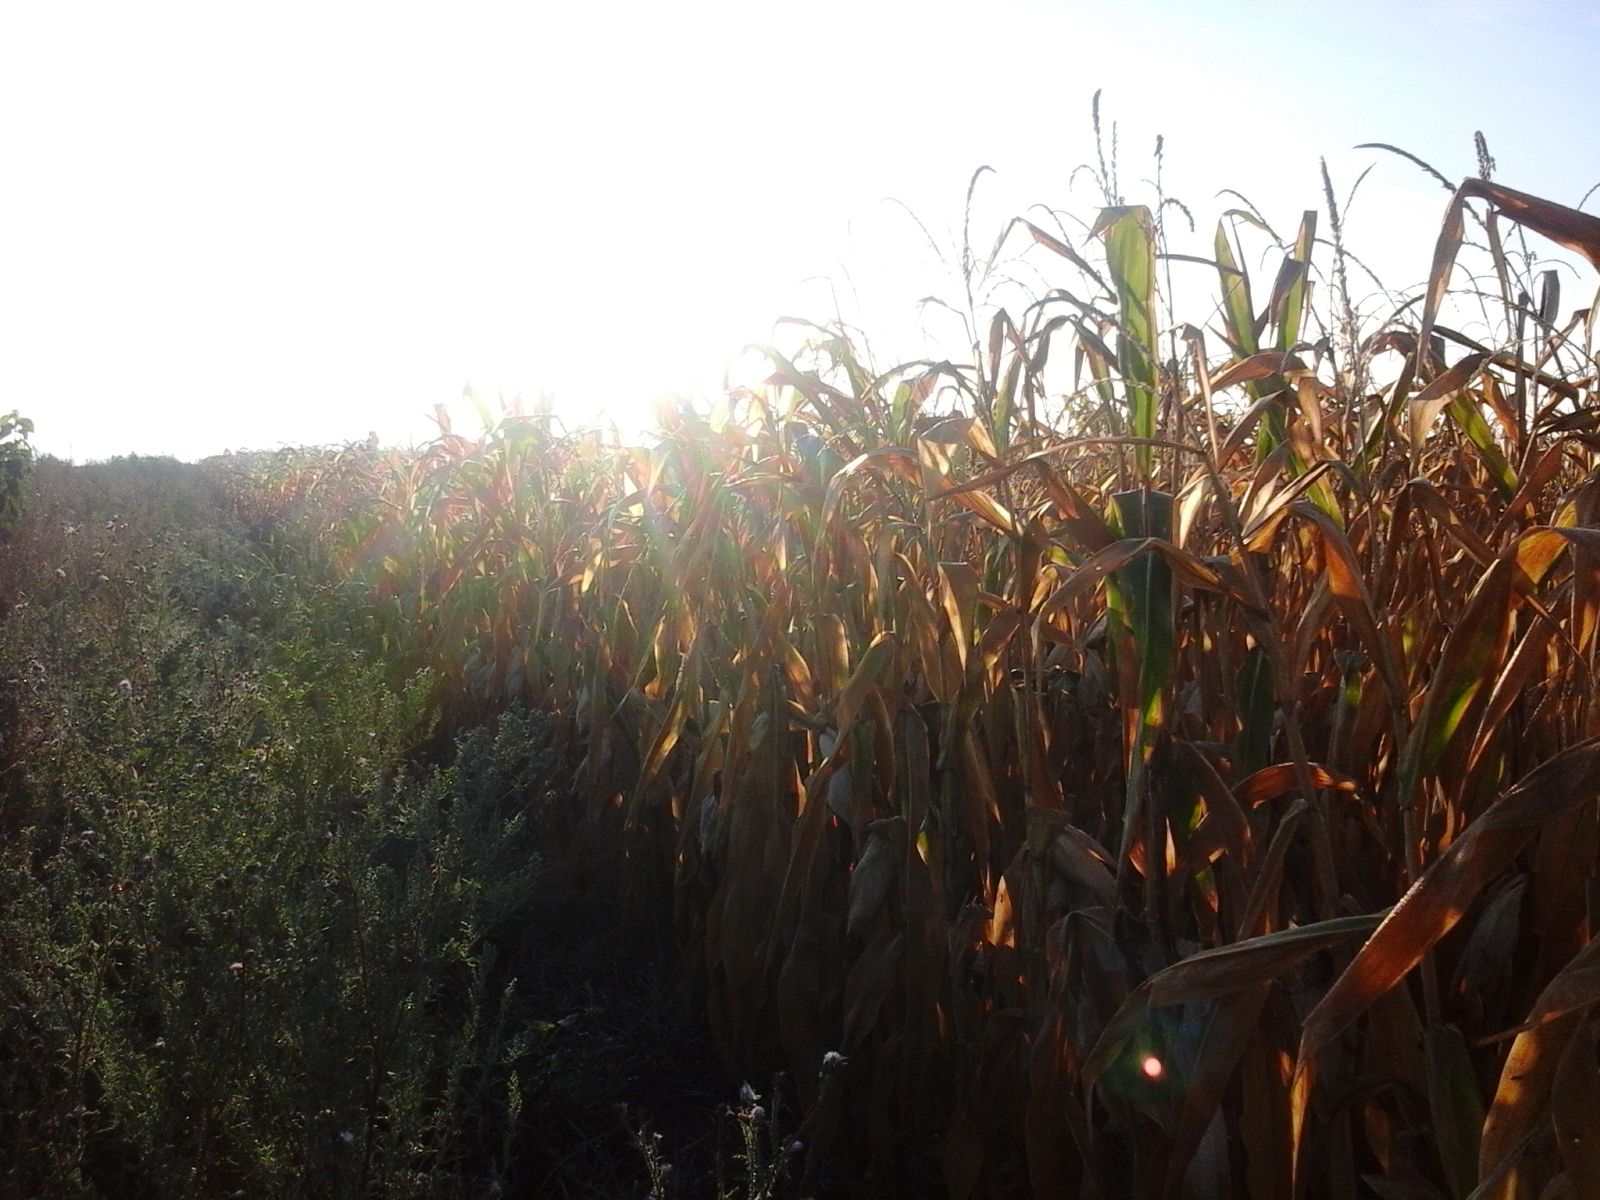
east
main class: Cropland
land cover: Maize
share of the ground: > 75 %
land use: Agriculture (excluding fallow land and kitchen gardens)
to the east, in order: Maize
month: August
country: RO
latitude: 45.9547
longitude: 21.0870
